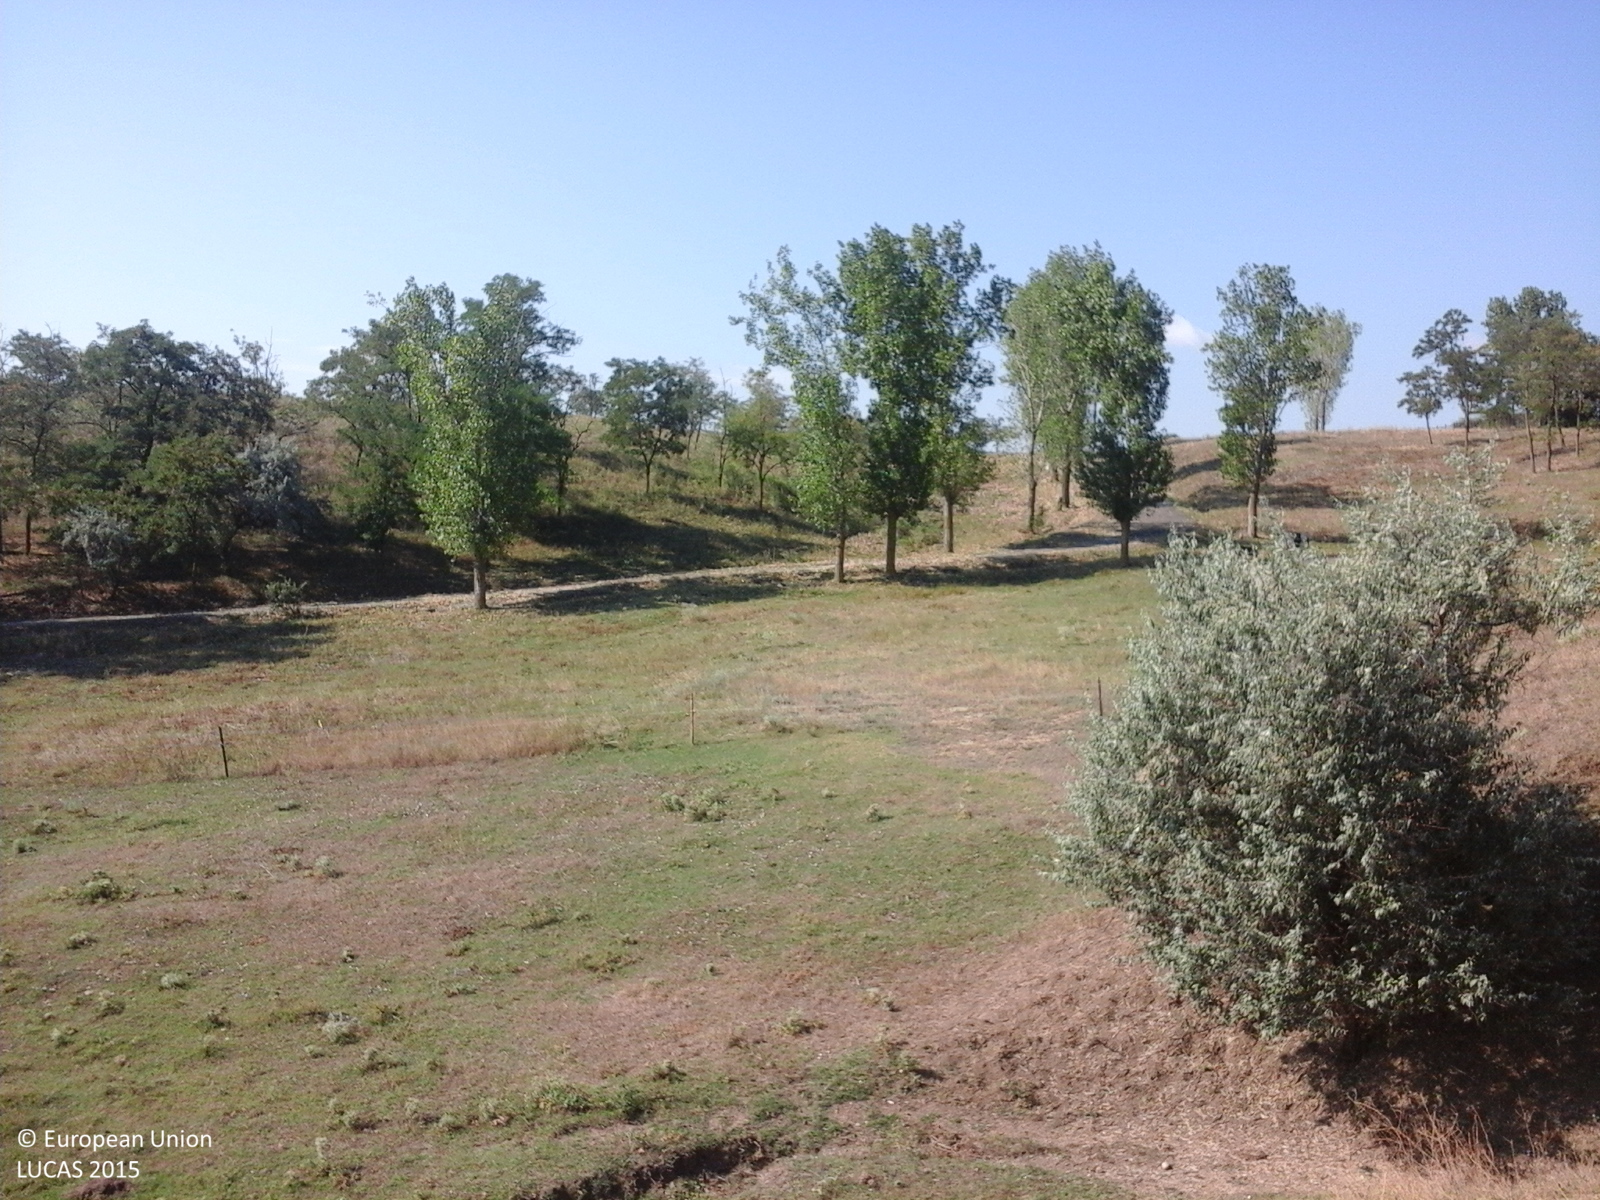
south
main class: Grassland
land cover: Grassland with sparse tree/shrub cover
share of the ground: > 75 %
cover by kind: herbaceous plants 85 %, shrubs 10 %, broadleaved forest trees 5 %
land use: Agriculture (excluding fallow land and kitchen gardens)
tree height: < 5 m
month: July
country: RO
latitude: 46.3138
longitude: 28.1411
